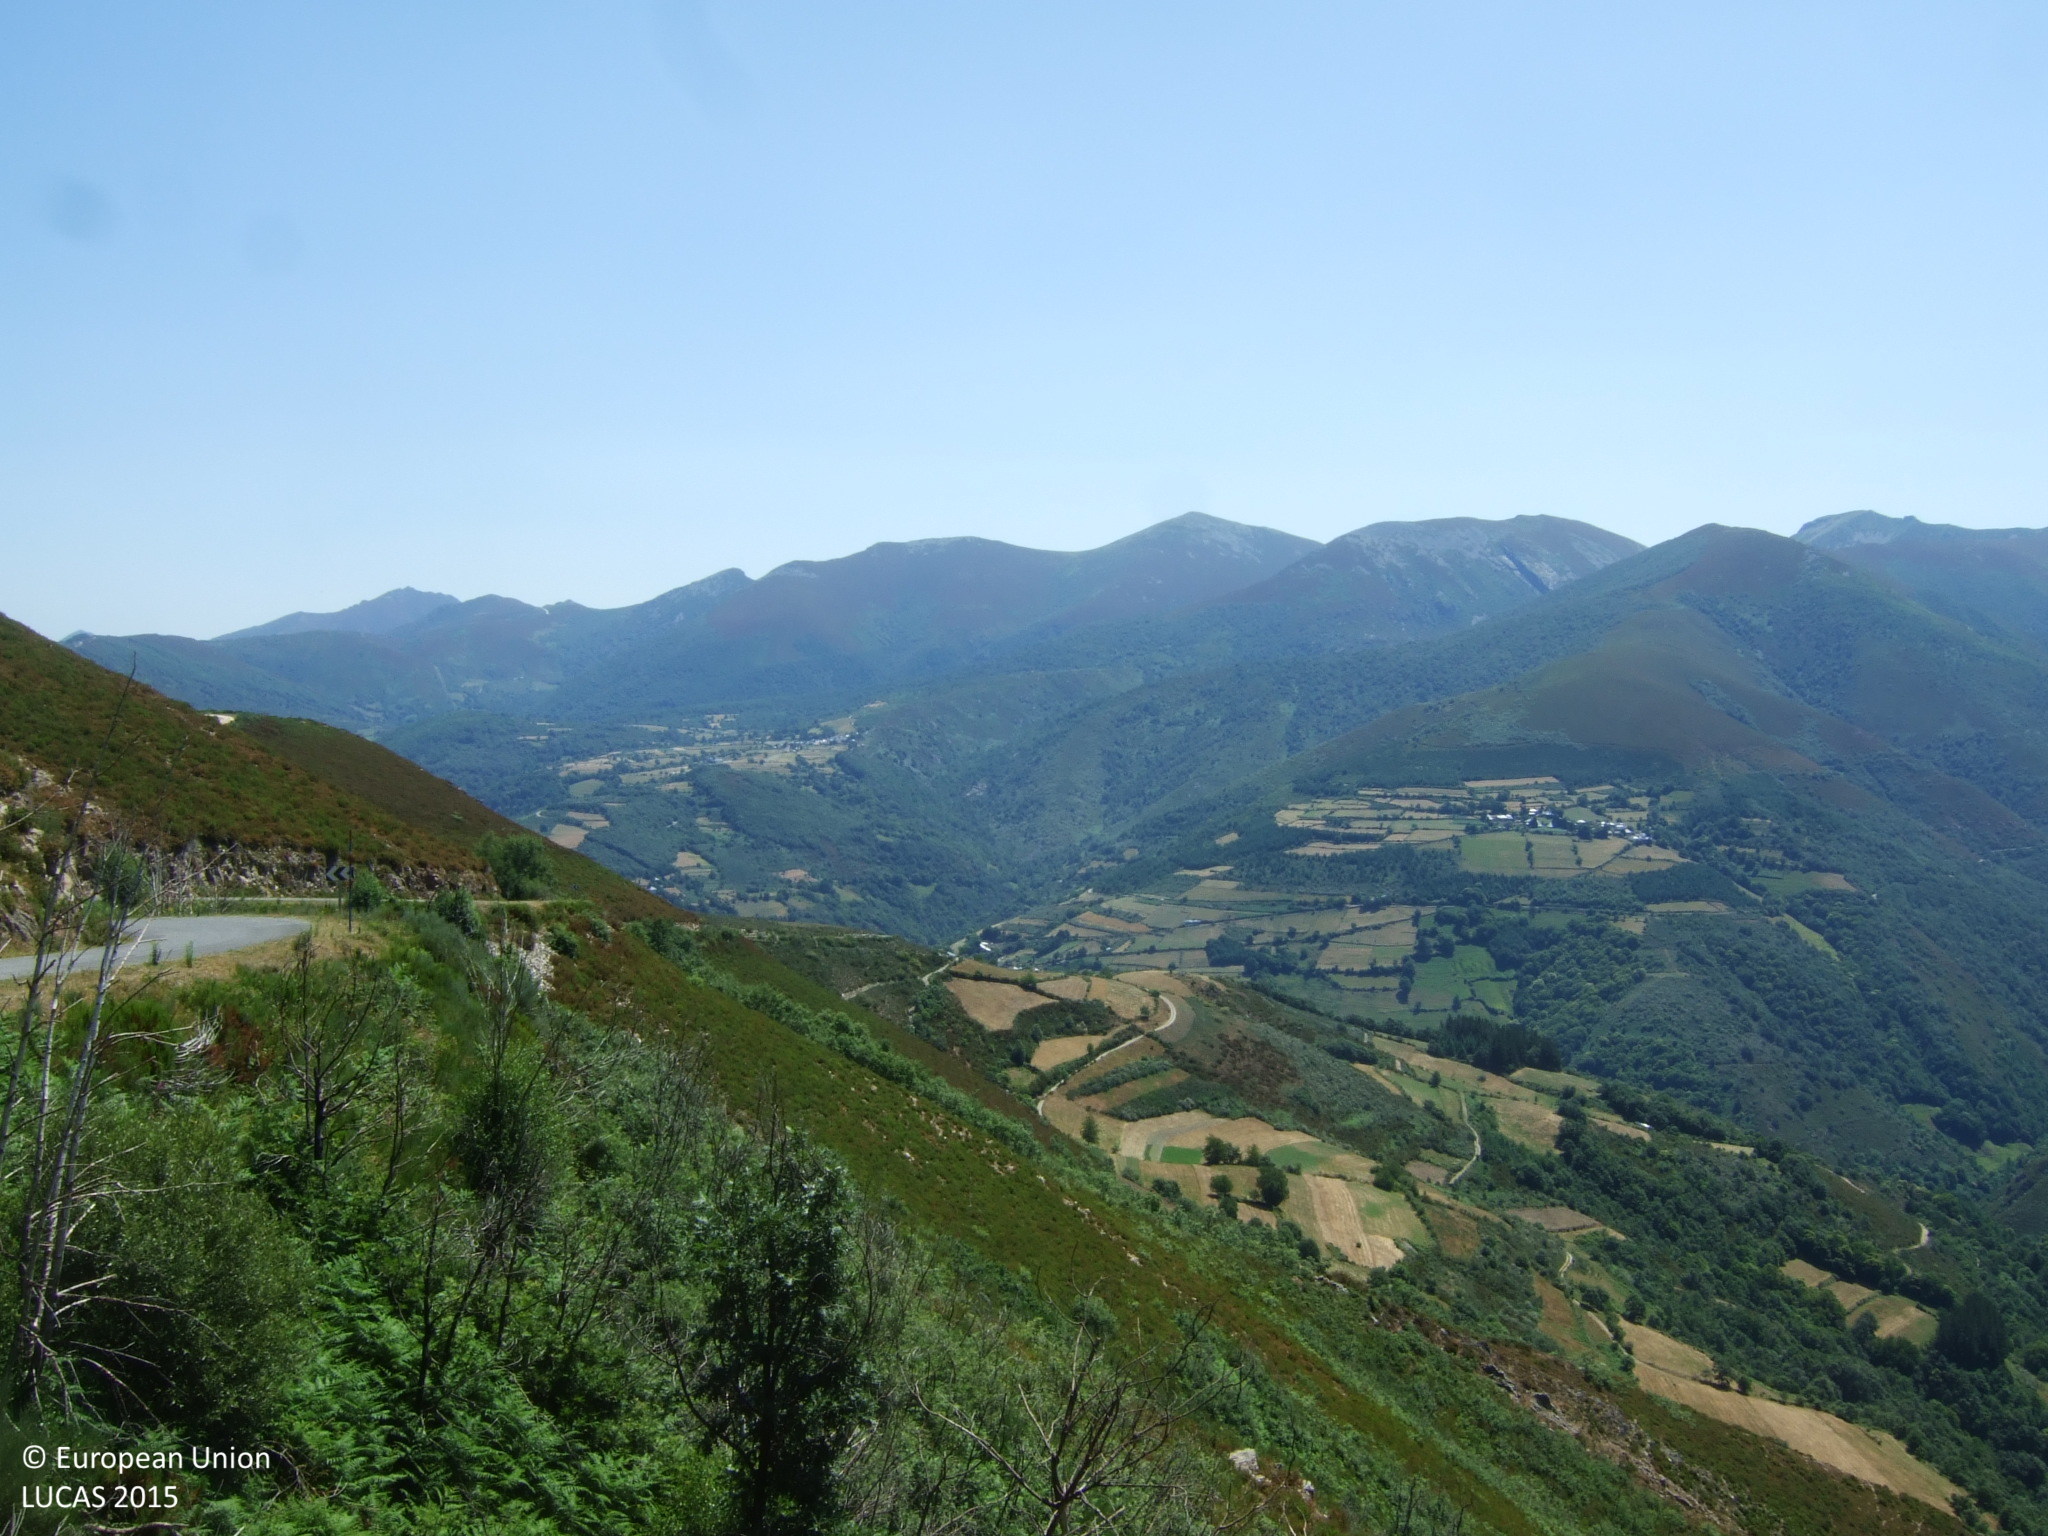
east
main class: Woodland
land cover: Broadleaved woodland
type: acidophilous oak and oak-birch forest
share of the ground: 25 - 50 %
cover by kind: shrubs 75 %, broadleaved forest trees 25 %
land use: Semi-natural and natural areas not in use
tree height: < 5 m
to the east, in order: Broadleaved woodland; Shrubland with sparse tree cover; Shrubland without tree cover; Broadleaved woodland
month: June
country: ES
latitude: 42.8542
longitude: -6.9347
